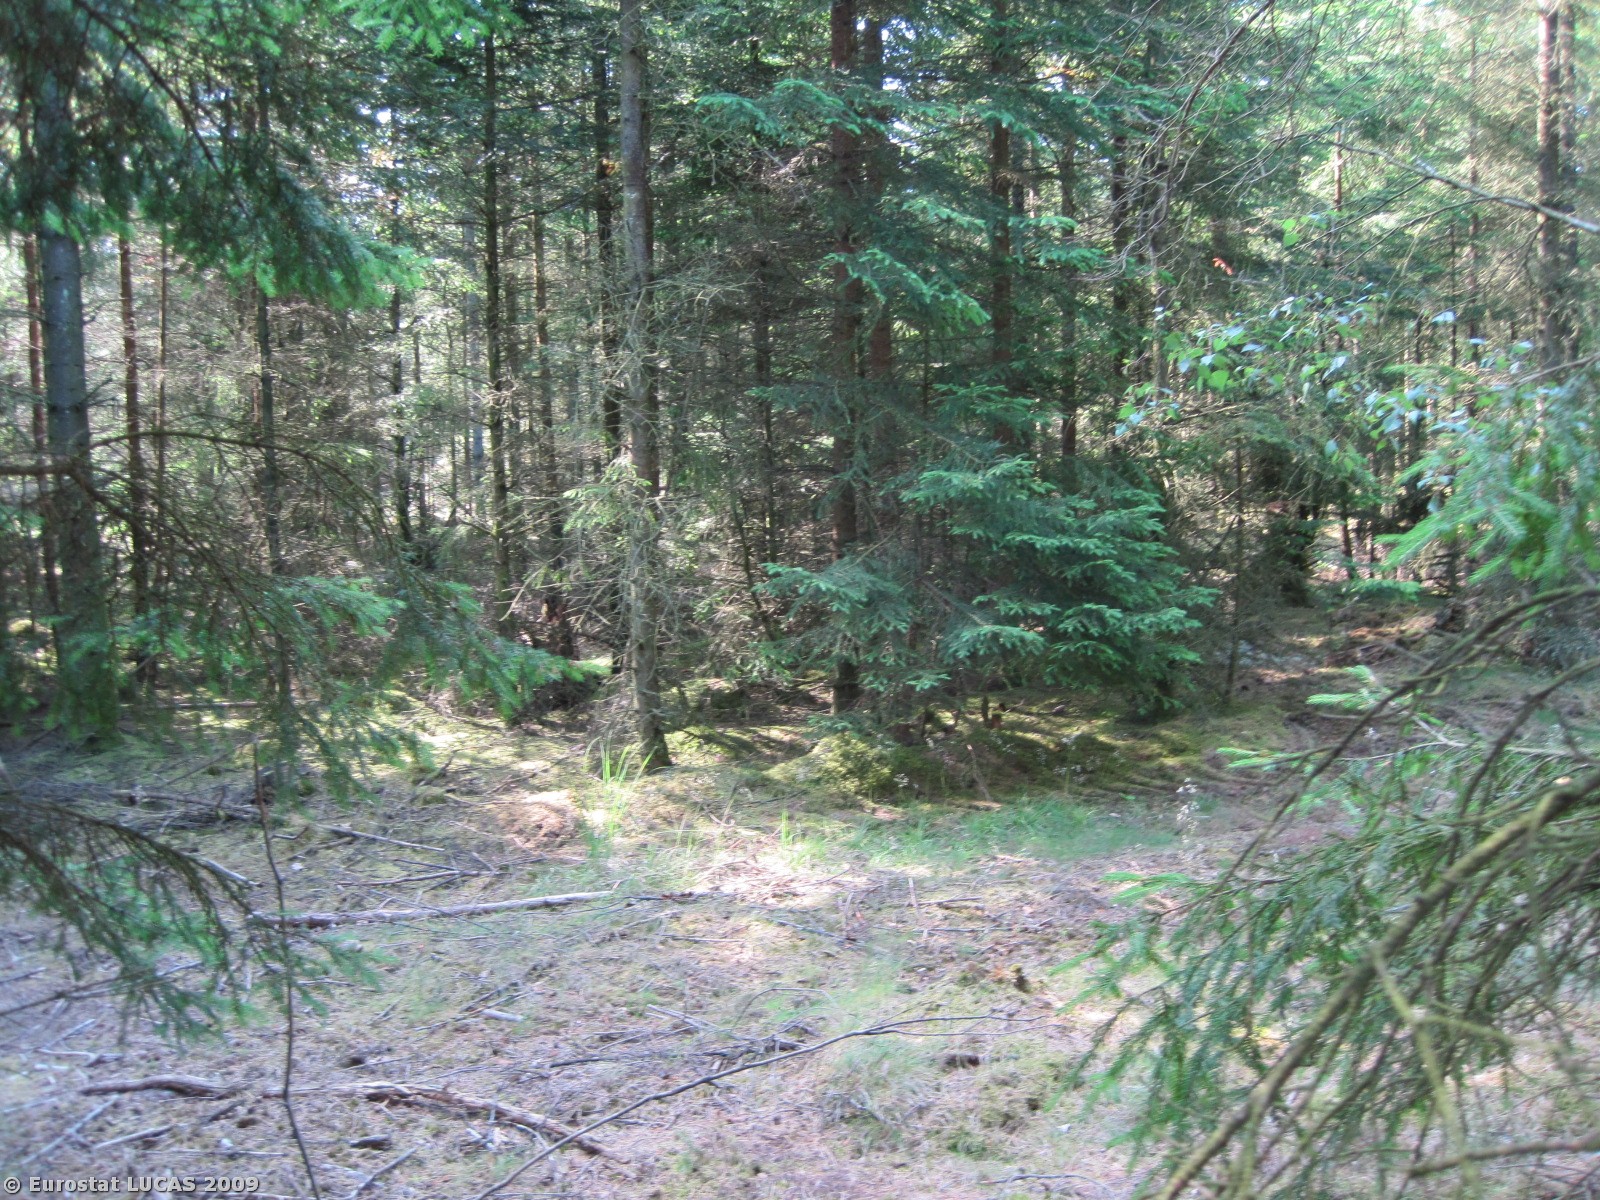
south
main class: Woodland
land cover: Coniferous woodland
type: plantations and self-sown exotic forest
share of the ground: > 75 %
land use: Forestry
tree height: > 5 m
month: July
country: DK
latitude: 56.5065
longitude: 8.8803
